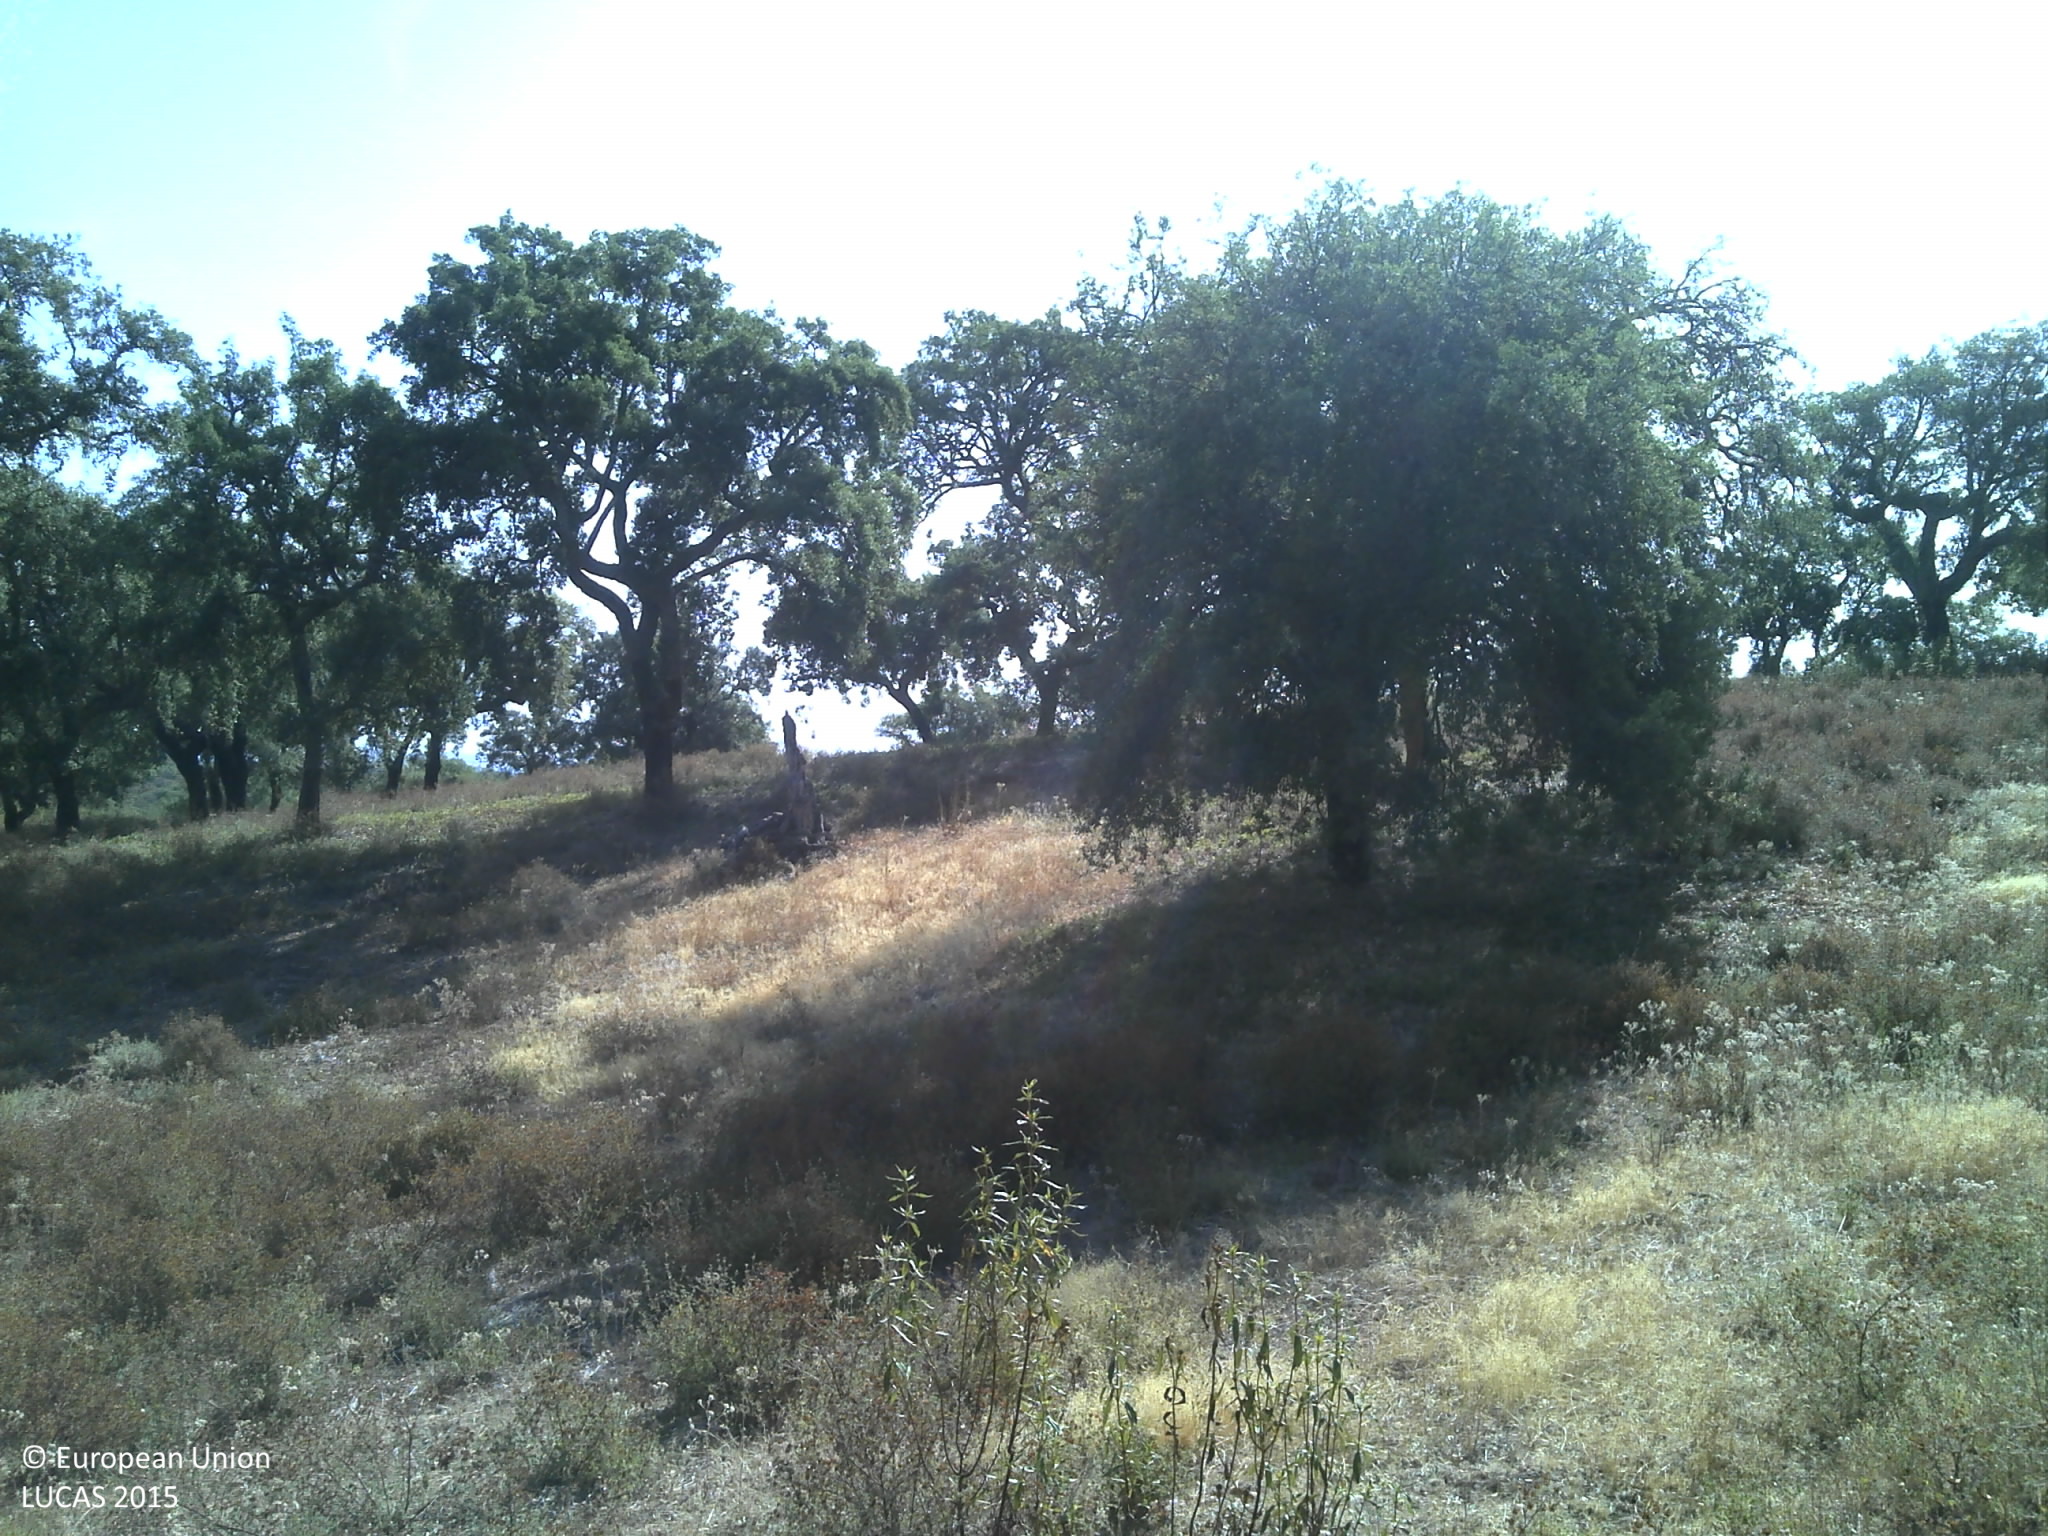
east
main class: Woodland
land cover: Broadleaved woodland
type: broadleaved evergreen forest
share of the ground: 10 - 25 %
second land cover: Grassland without tree/shrub cover
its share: 25 - 50 %
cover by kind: unconsolidated bare surface 50 %, herbaceous plants 30 %, broadleaved forest trees 20 %
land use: Forestry
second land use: Agriculture (excluding fallow land and kitchen gardens)
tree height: > 5 m
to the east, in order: Broadleaved woodland; Grassland without tree/shrub cover; Broadleaved woodland
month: July
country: PT
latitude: 38.3646
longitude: -7.8072
